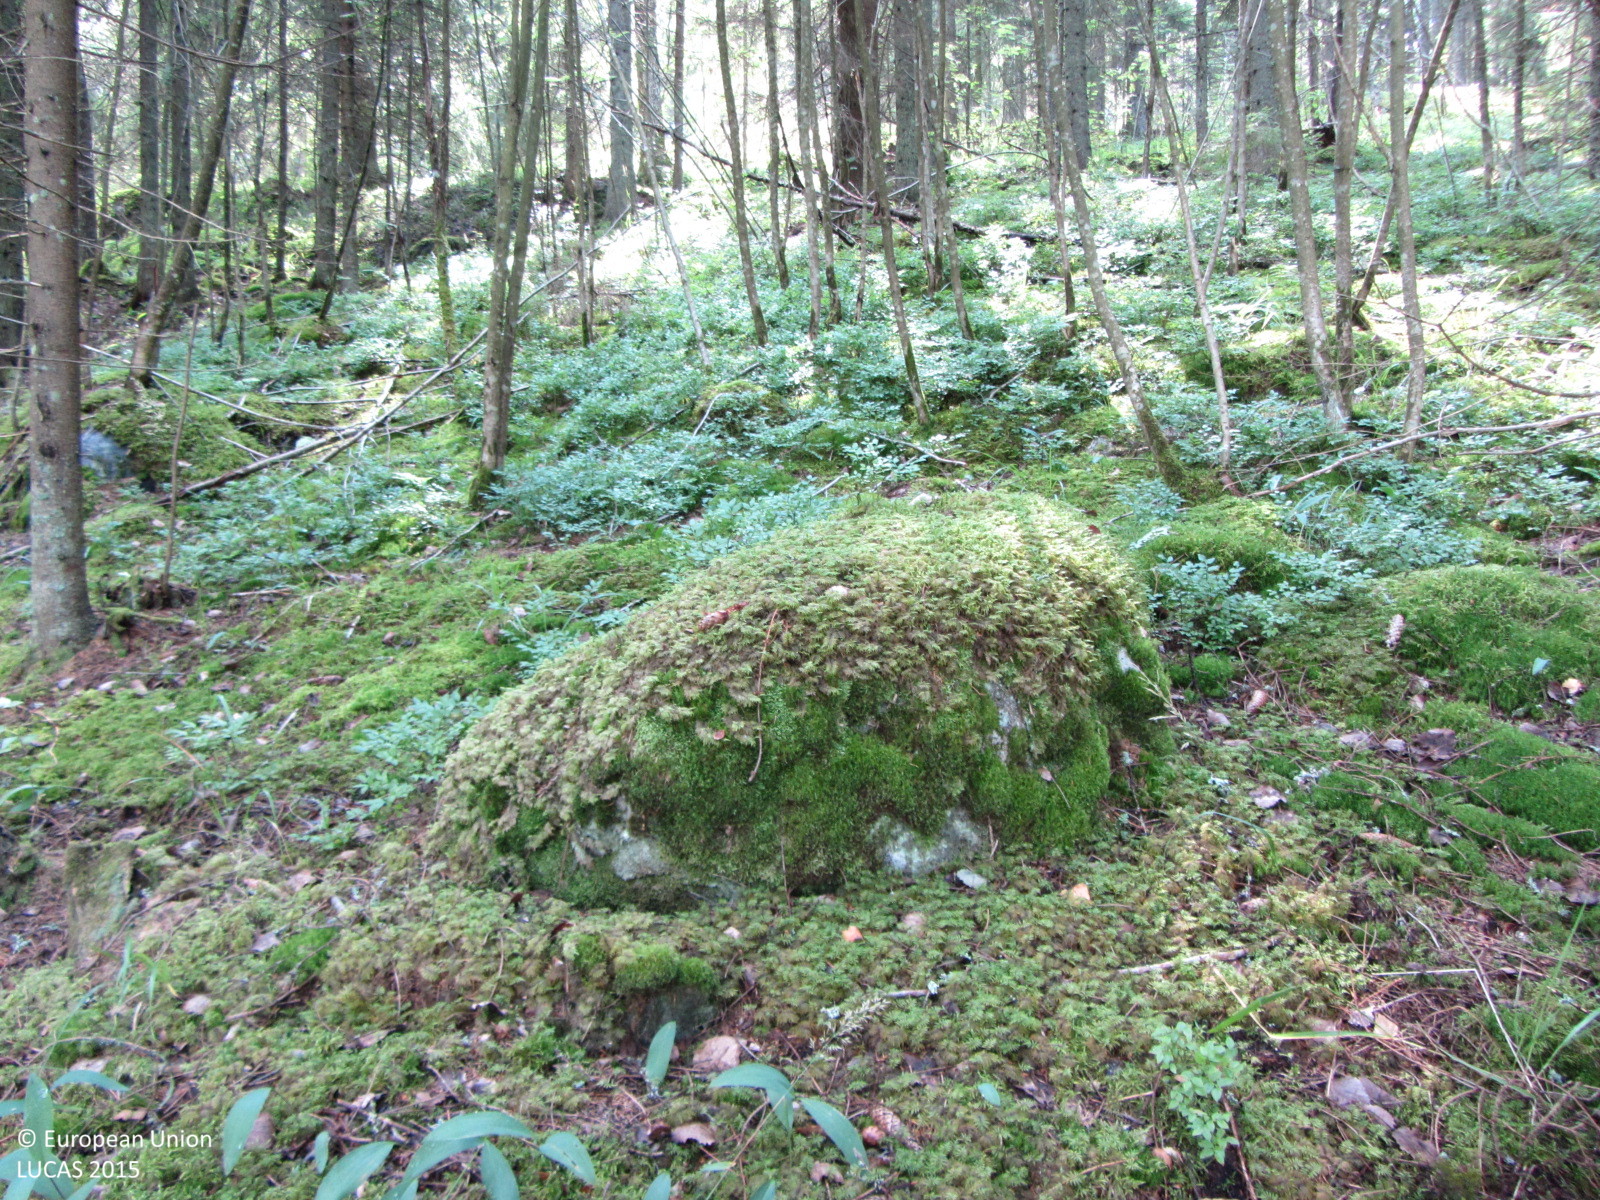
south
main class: Woodland
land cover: Spruce dominated mixed woodland
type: boreal forest
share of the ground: > 75 %
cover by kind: coniferous forest trees 50 %, broadleaved forest trees 40 %, shrubs 5 %, lichens and mosses 5 %
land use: Forestry
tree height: > 5 m
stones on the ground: < 10 %
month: August
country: FI
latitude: 60.1918
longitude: 24.1871
